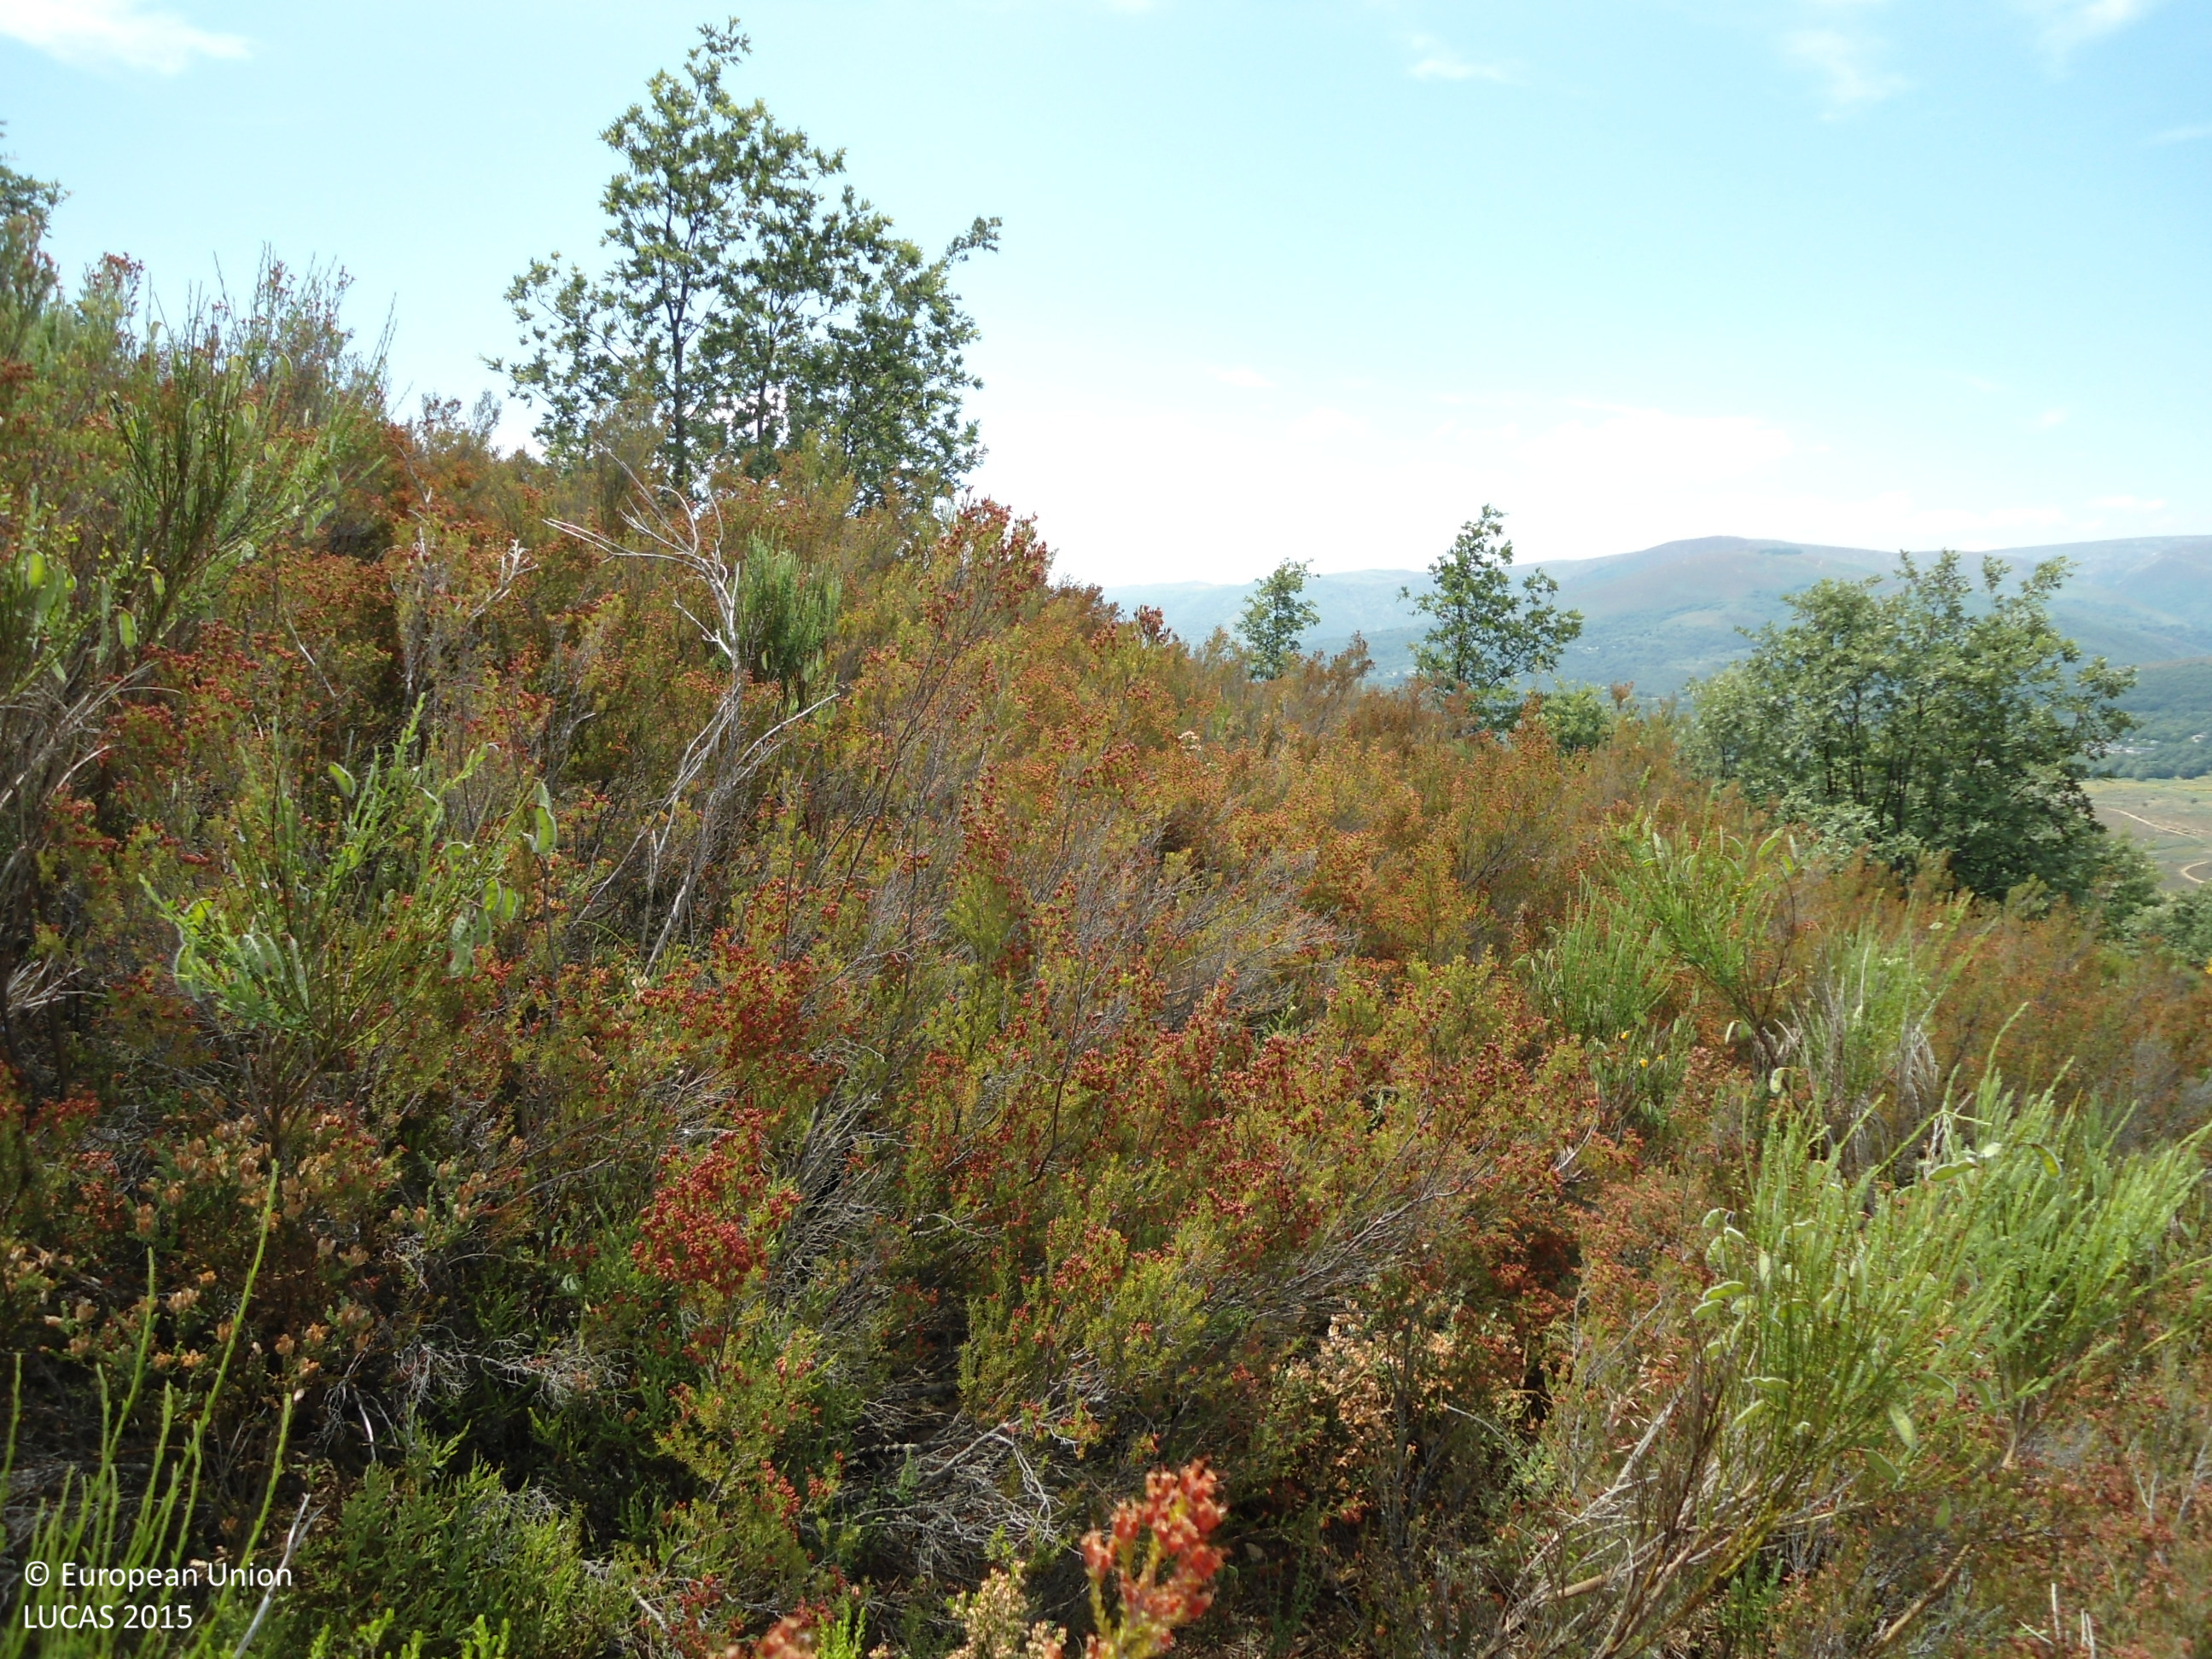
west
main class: Shrubland
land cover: Shrubland with sparse tree cover
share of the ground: > 75 %
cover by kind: shrubs 95 %, broadleaved forest trees 5 %
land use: Semi-natural and natural areas not in use
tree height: < 5 m
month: June
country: ES
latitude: 42.1193
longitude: -6.5999
